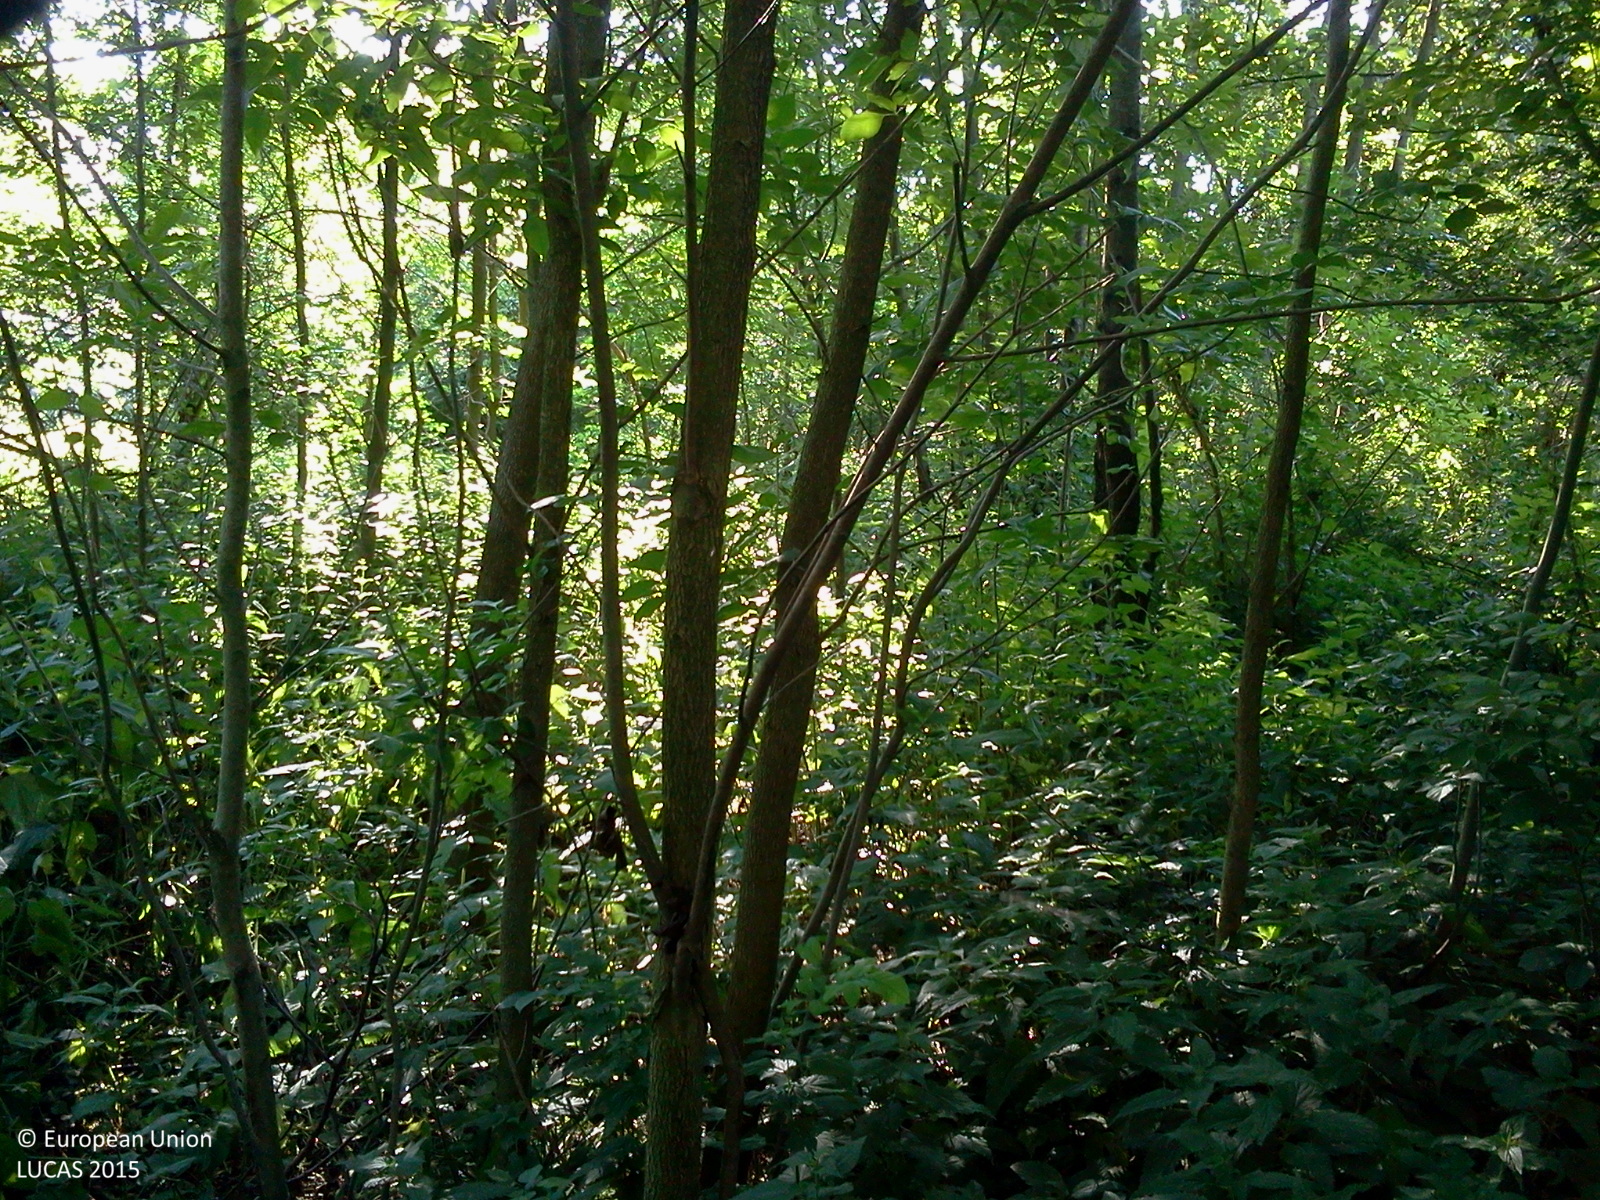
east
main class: Woodland
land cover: Broadleaved woodland
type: thermophilous deciduous forest
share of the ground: > 75 %
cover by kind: broadleaved forest trees 65 %, shrubs 20 %, herbaceous plants 15 %
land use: Forestry
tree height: > 5 m
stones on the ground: < 10 %
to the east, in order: Broadleaved woodland; Ditches and canals; Shrubland with sparse tree cover; Tracks; Grassland with sparse tree/shrub cover; Electric lines; Broadleaved woodland; Tracks; Electric lines; Shrubland with sparse tree cover; Fences; Maize; Electric lines; Maize
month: June
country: HU
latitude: 46.6950
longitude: 17.0784
